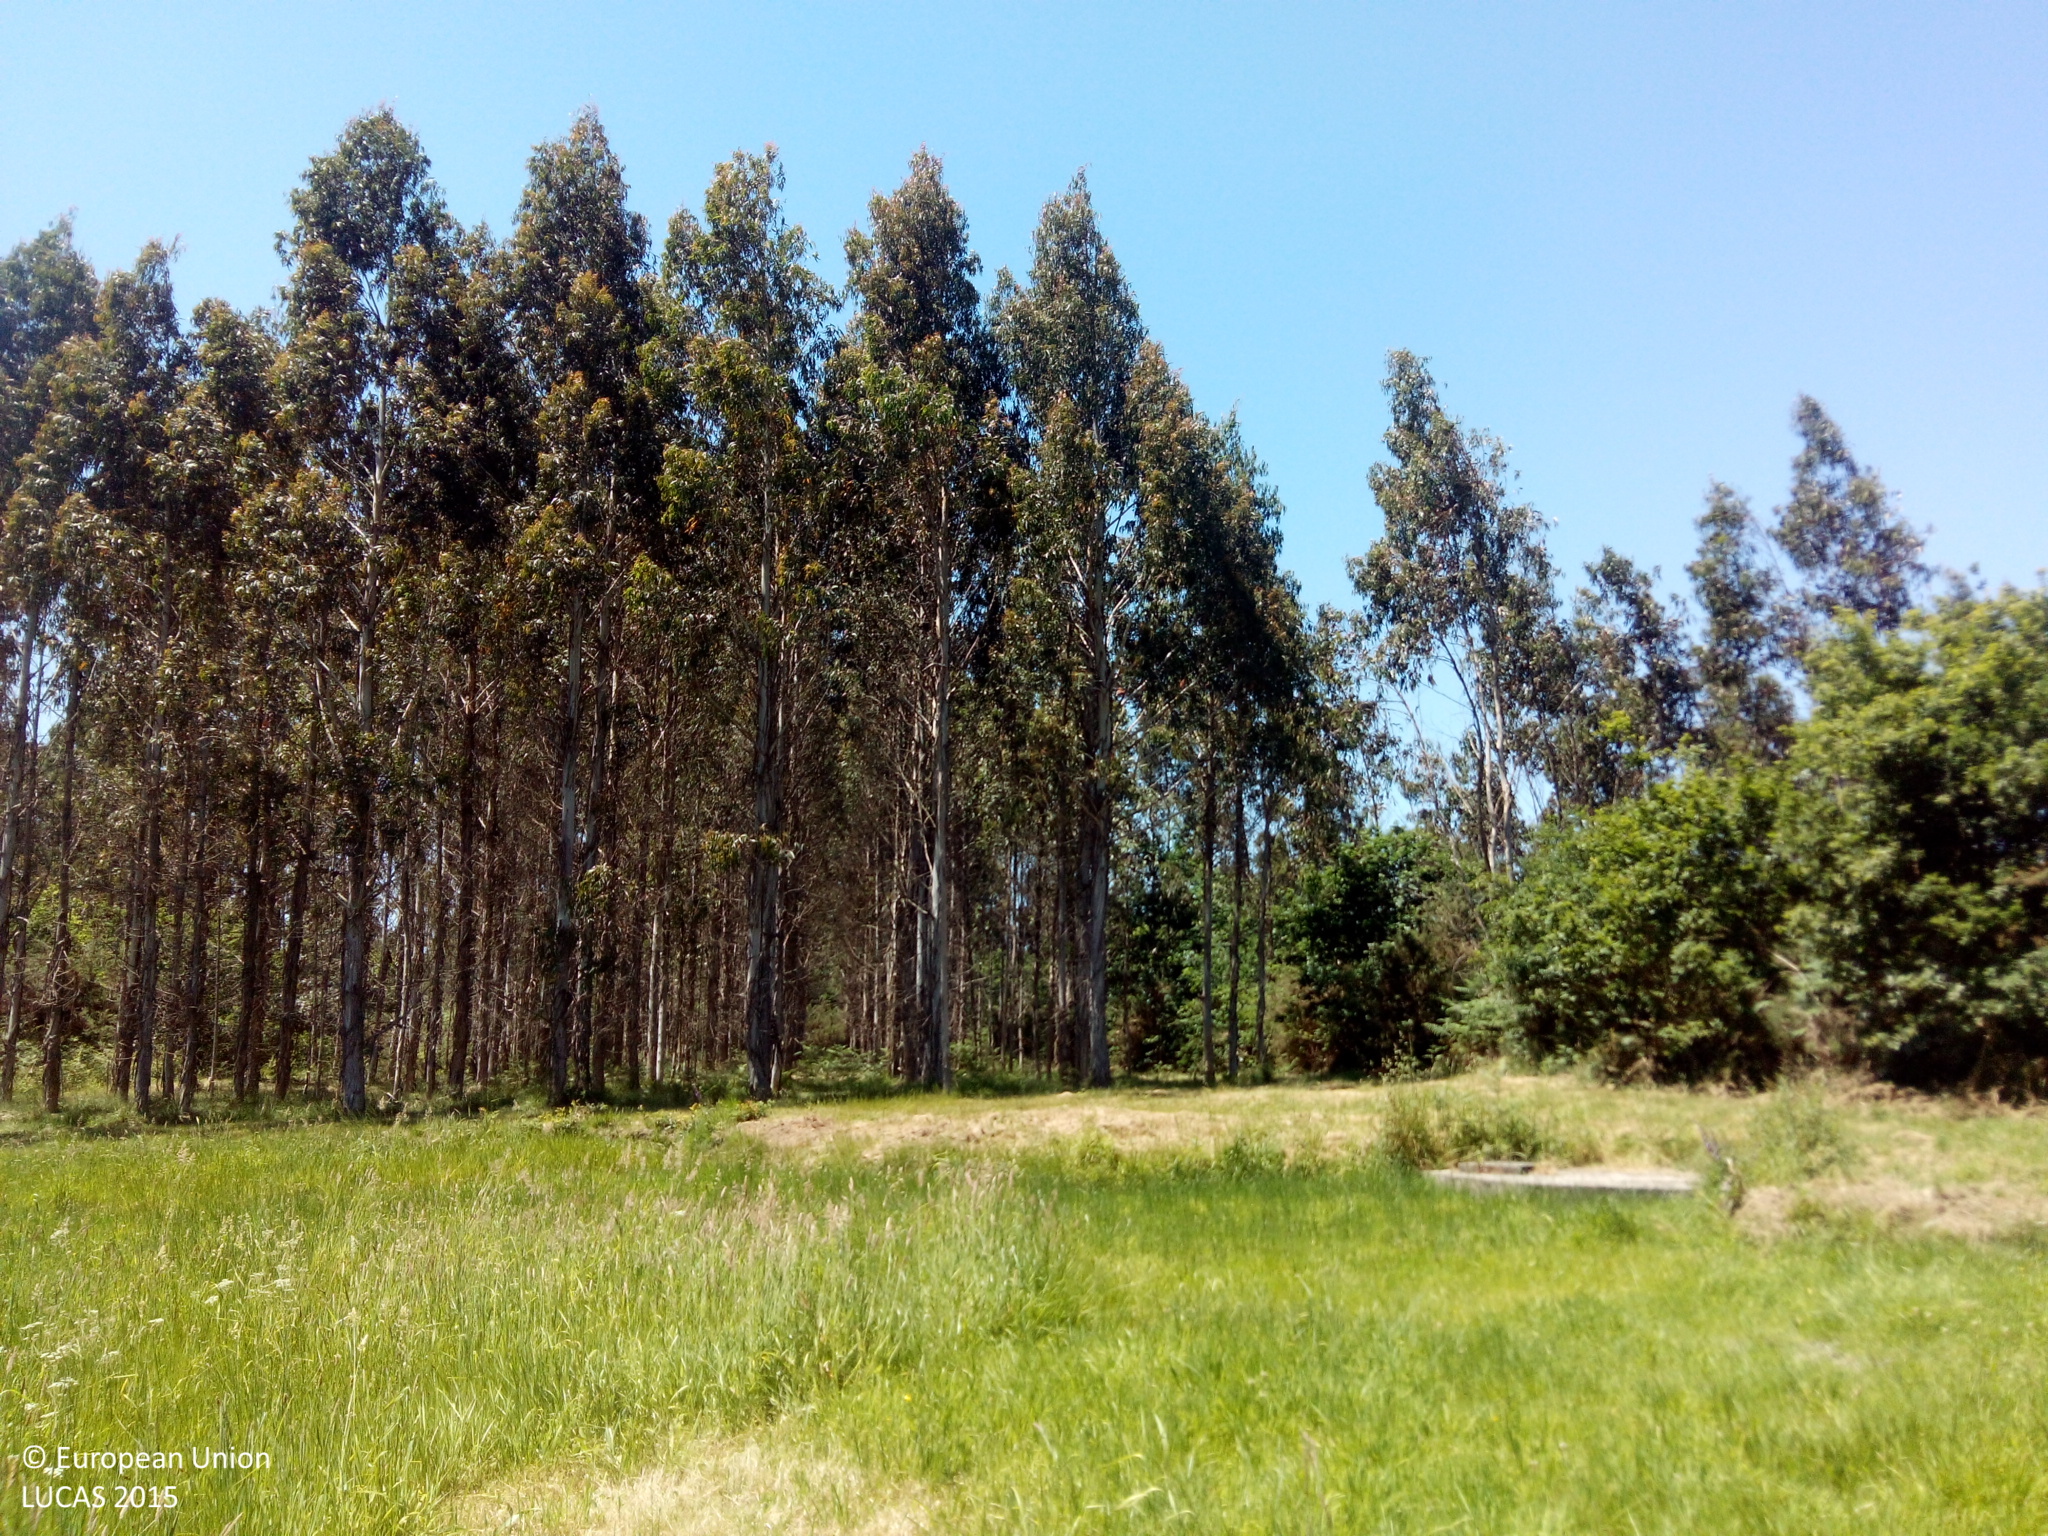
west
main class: Grassland
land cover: Grassland without tree/shrub cover
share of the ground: > 75 %
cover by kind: herbaceous plants 100 %
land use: Agriculture (excluding fallow land and kitchen gardens)
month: May
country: ES
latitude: 42.8281
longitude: -8.5386
